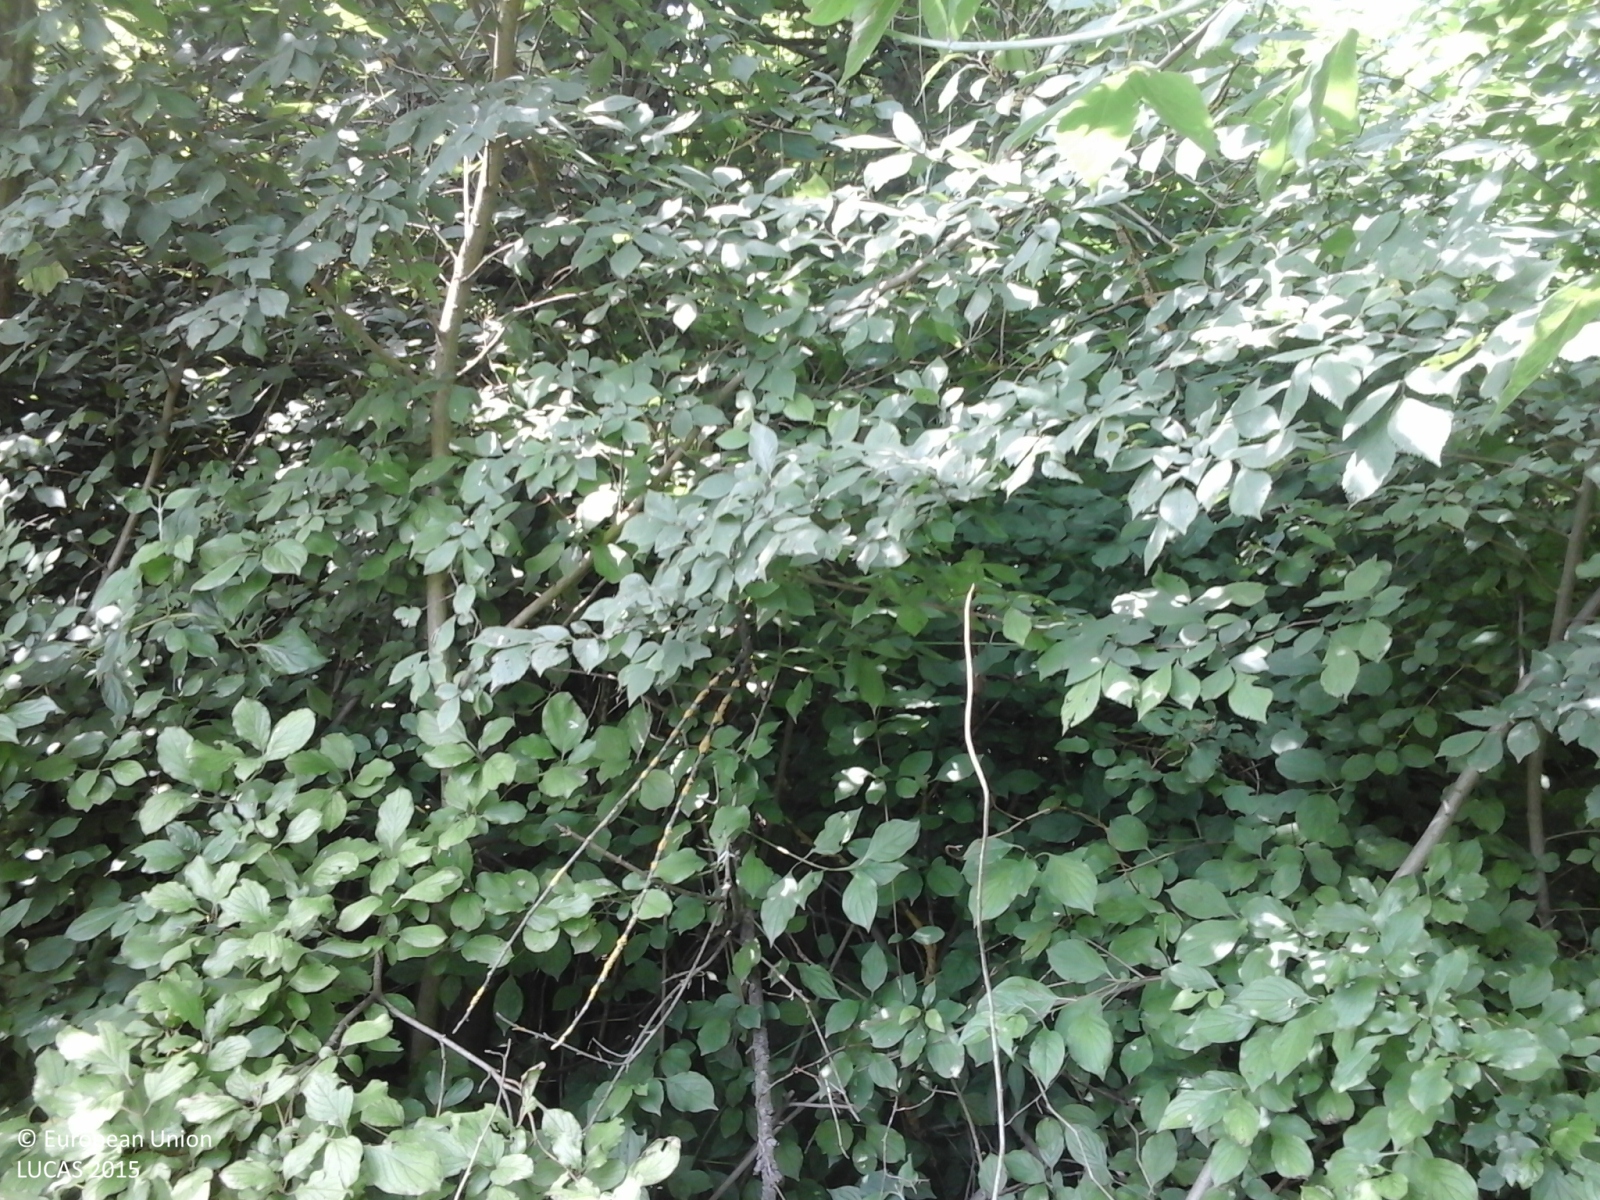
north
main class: Woodland
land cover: Broadleaved woodland
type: thermophilous deciduous forest
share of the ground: > 75 %
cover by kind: broadleaved forest trees 80 %, shrubs 10 %, herbaceous plants 10 %
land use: Semi-natural and natural areas not in use
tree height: > 5 m
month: June
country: IT
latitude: 45.0054
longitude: 8.3918
